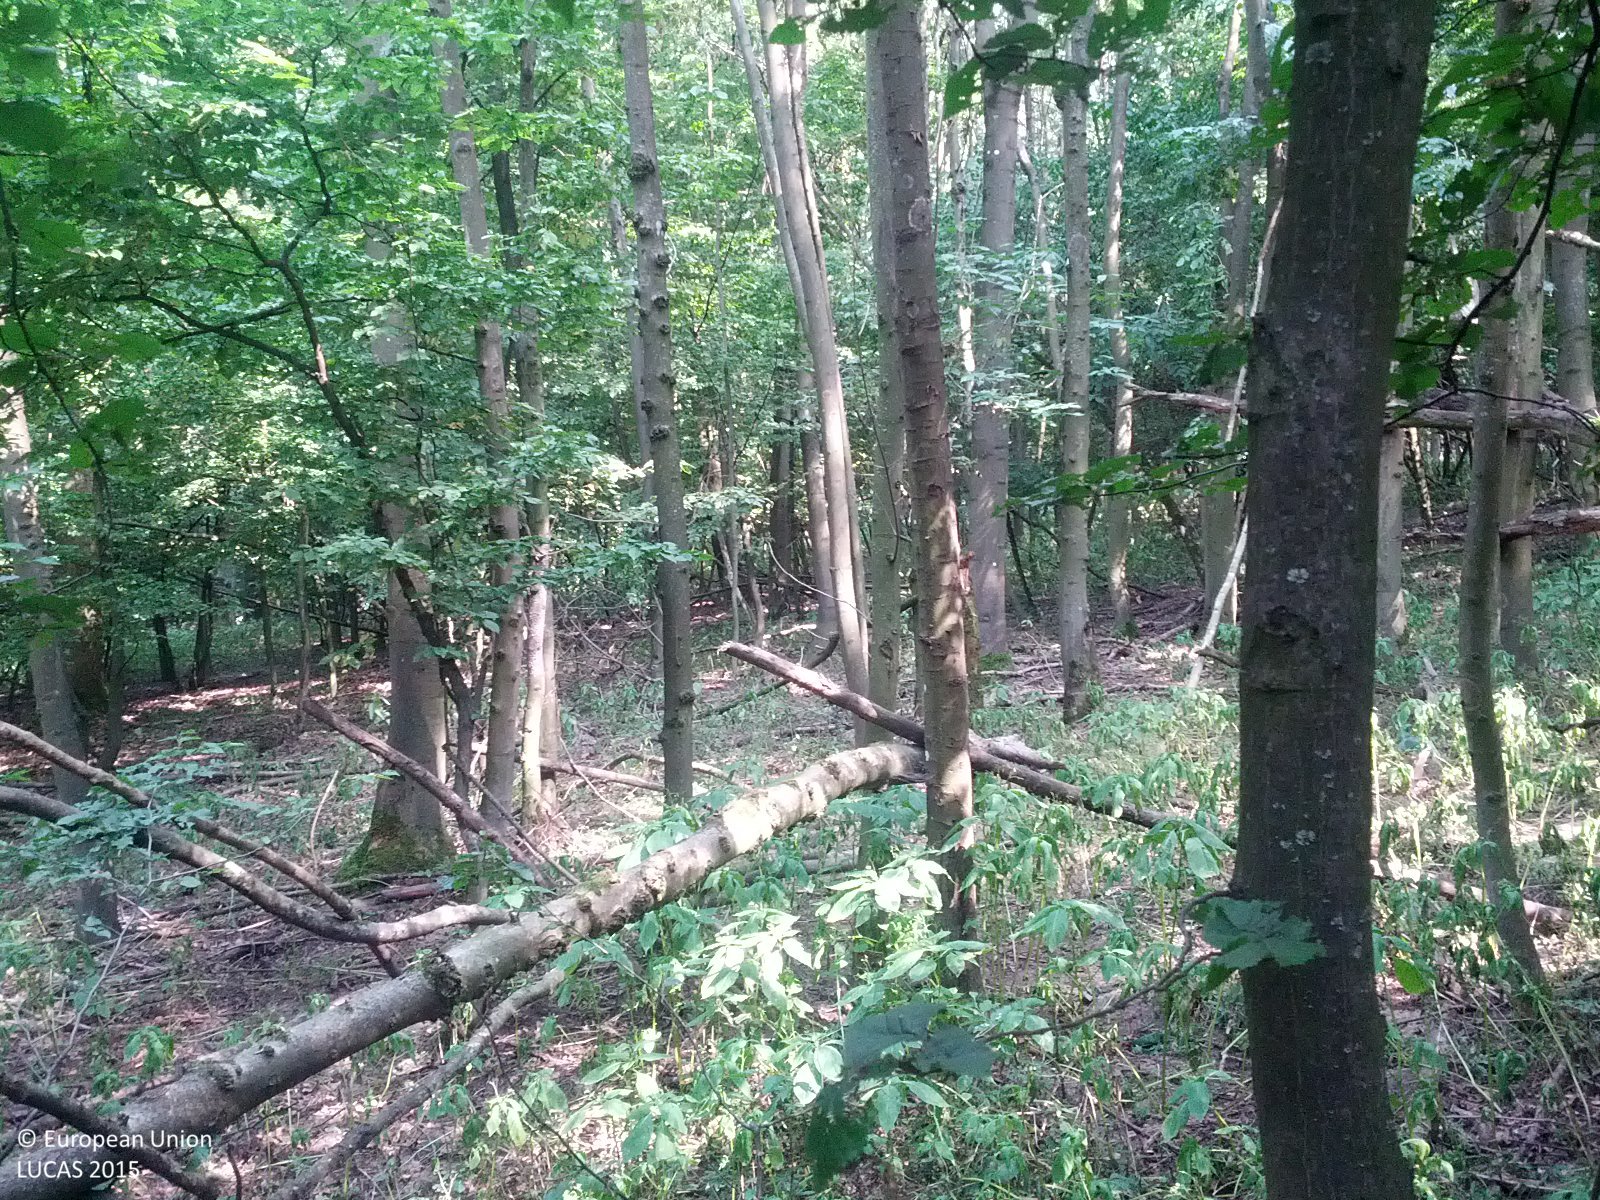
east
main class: Woodland
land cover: Broadleaved woodland
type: beech forest
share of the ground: > 75 %
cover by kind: broadleaved forest trees 95 %, herbaceous plants 5 %
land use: Forestry
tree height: > 5 m
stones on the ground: < 10 %
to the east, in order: Broadleaved woodland; Spruce dominated coniferous woodland; Broadleaved woodland
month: July
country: AT
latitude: 48.4035
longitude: 16.3134
